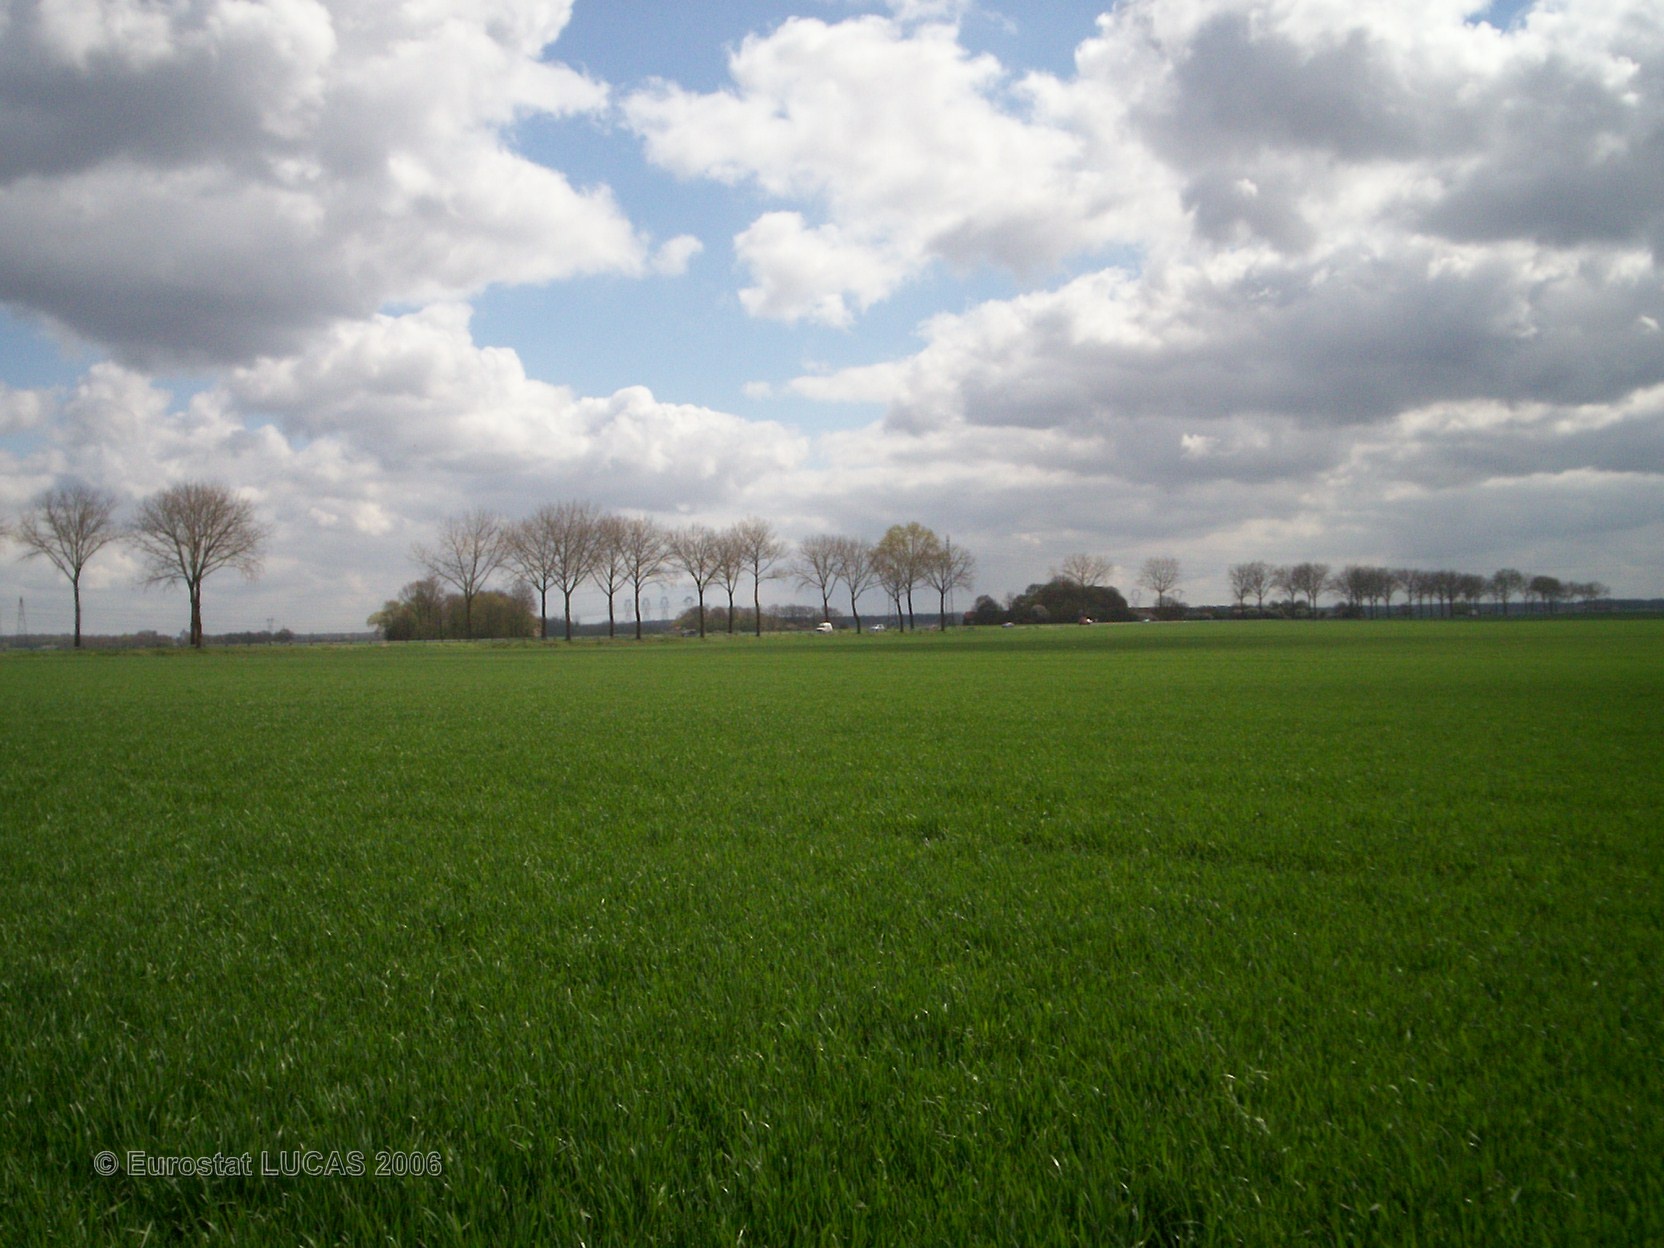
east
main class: Cropland
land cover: Common wheat
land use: Agriculture (excluding fallow land and kitchen gardens)
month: April
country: FR
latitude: 48.4941
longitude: 2.8054
